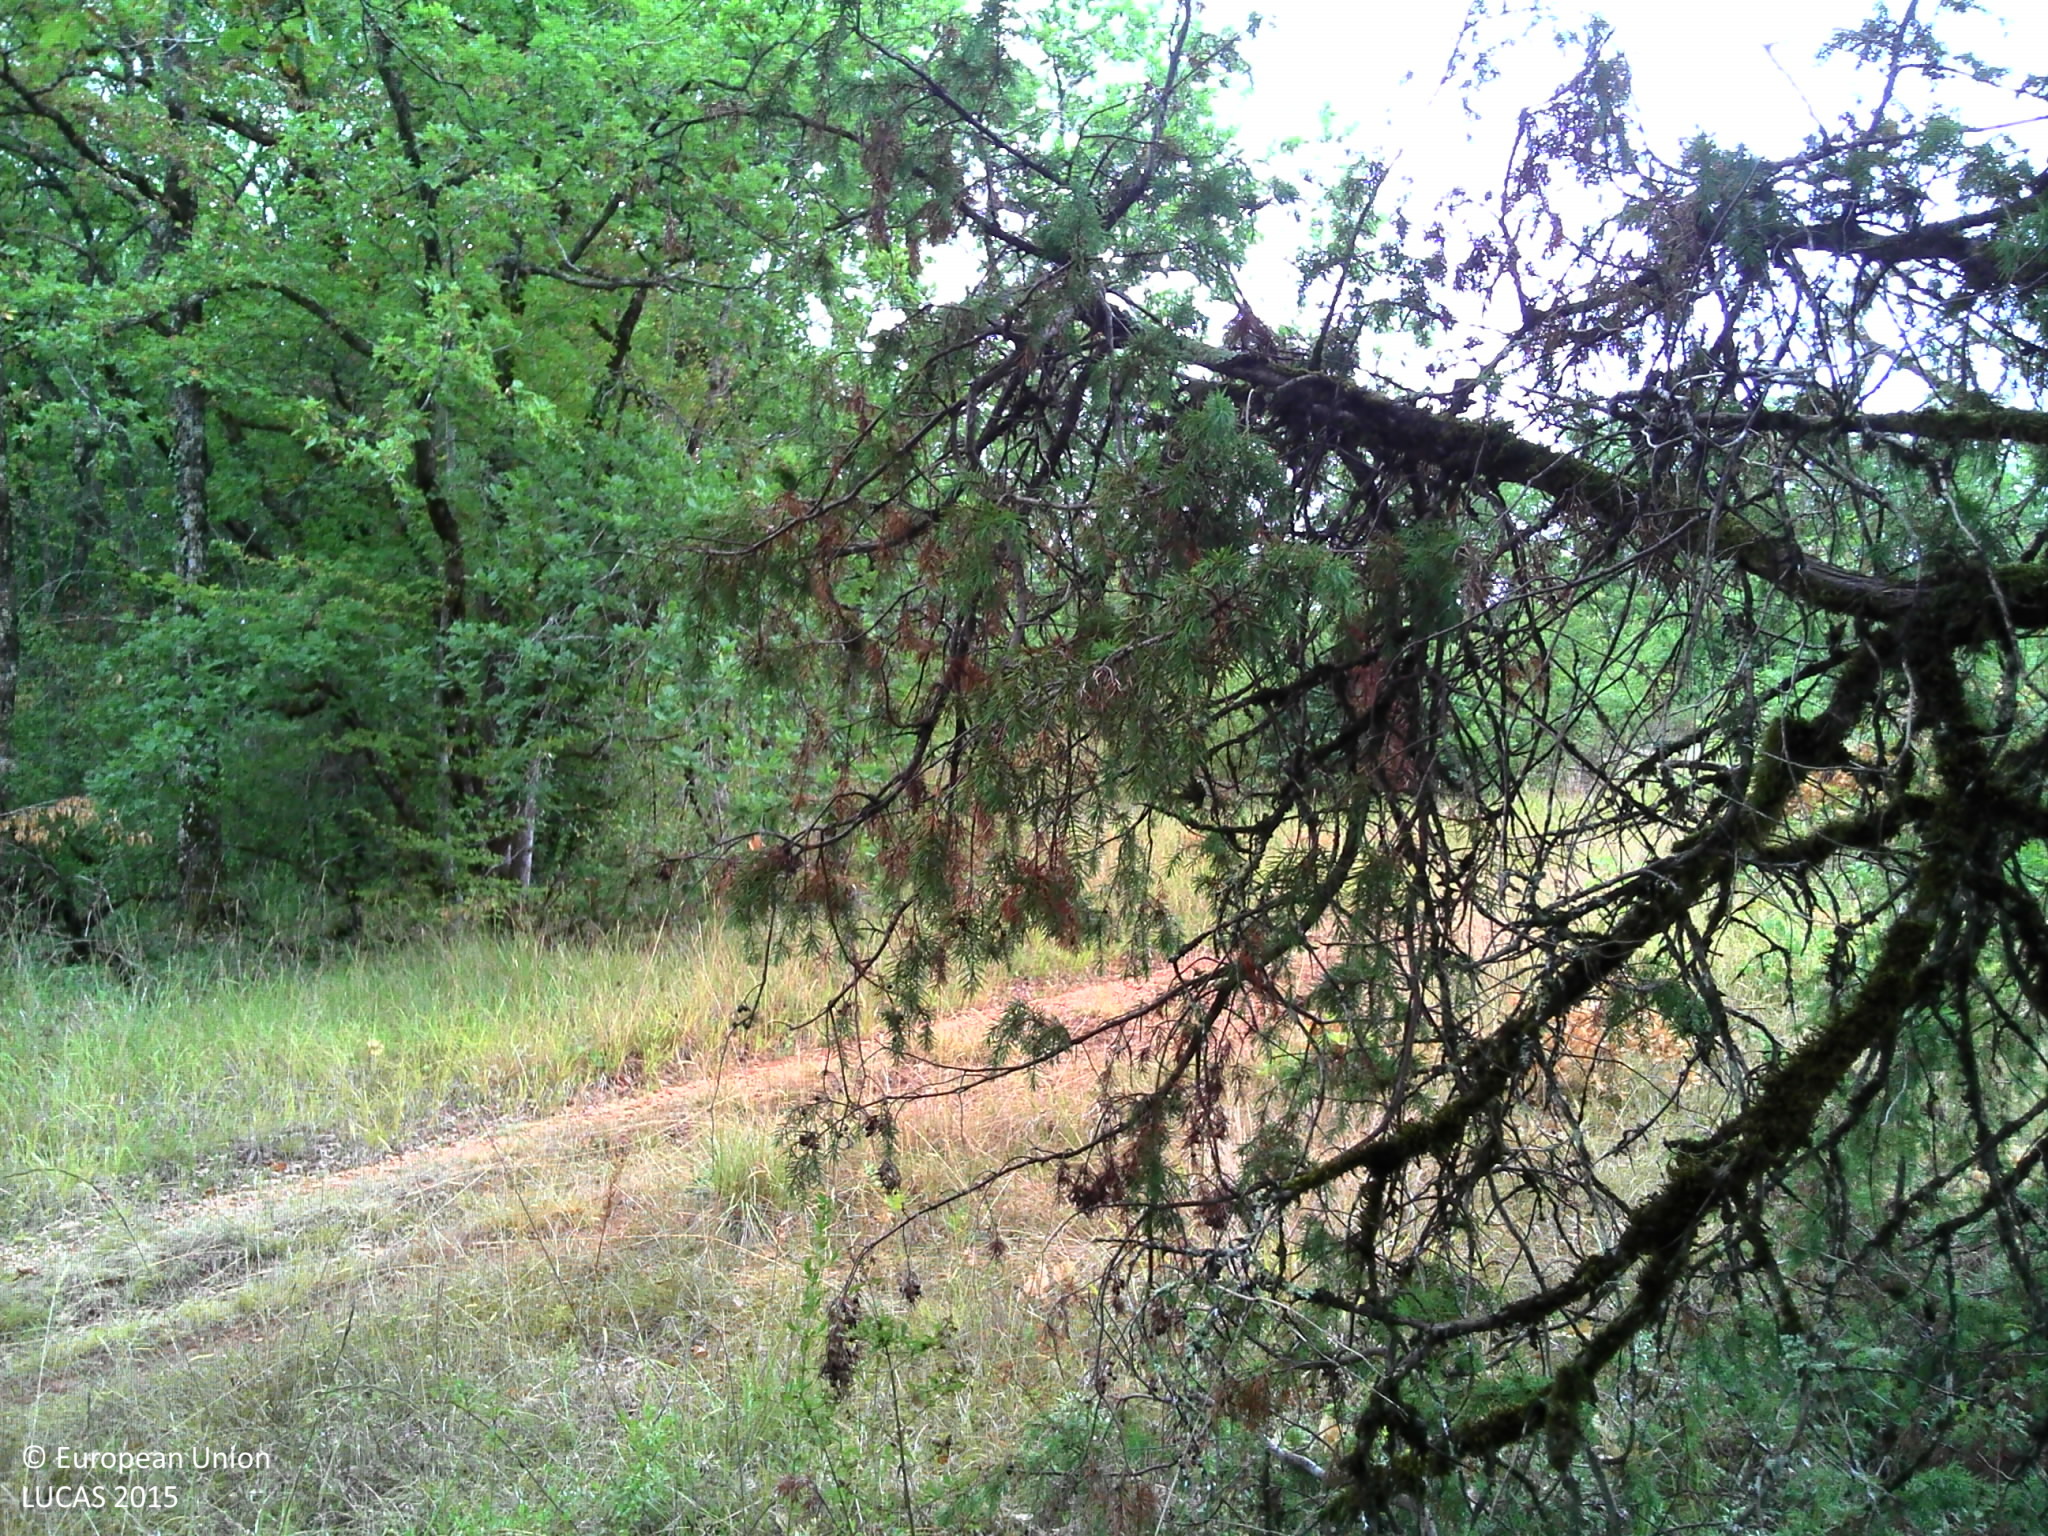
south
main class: Woodland
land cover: Broadleaved woodland
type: acidophilous oak and oak-birch forest
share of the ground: > 75 %
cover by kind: broadleaved forest trees 65 %, herbaceous plants 25 %, coniferous forest trees 5 %, shrubs 5 %
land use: Forestry
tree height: > 5 m
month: July
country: FR
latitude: 45.0106
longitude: 1.4309
